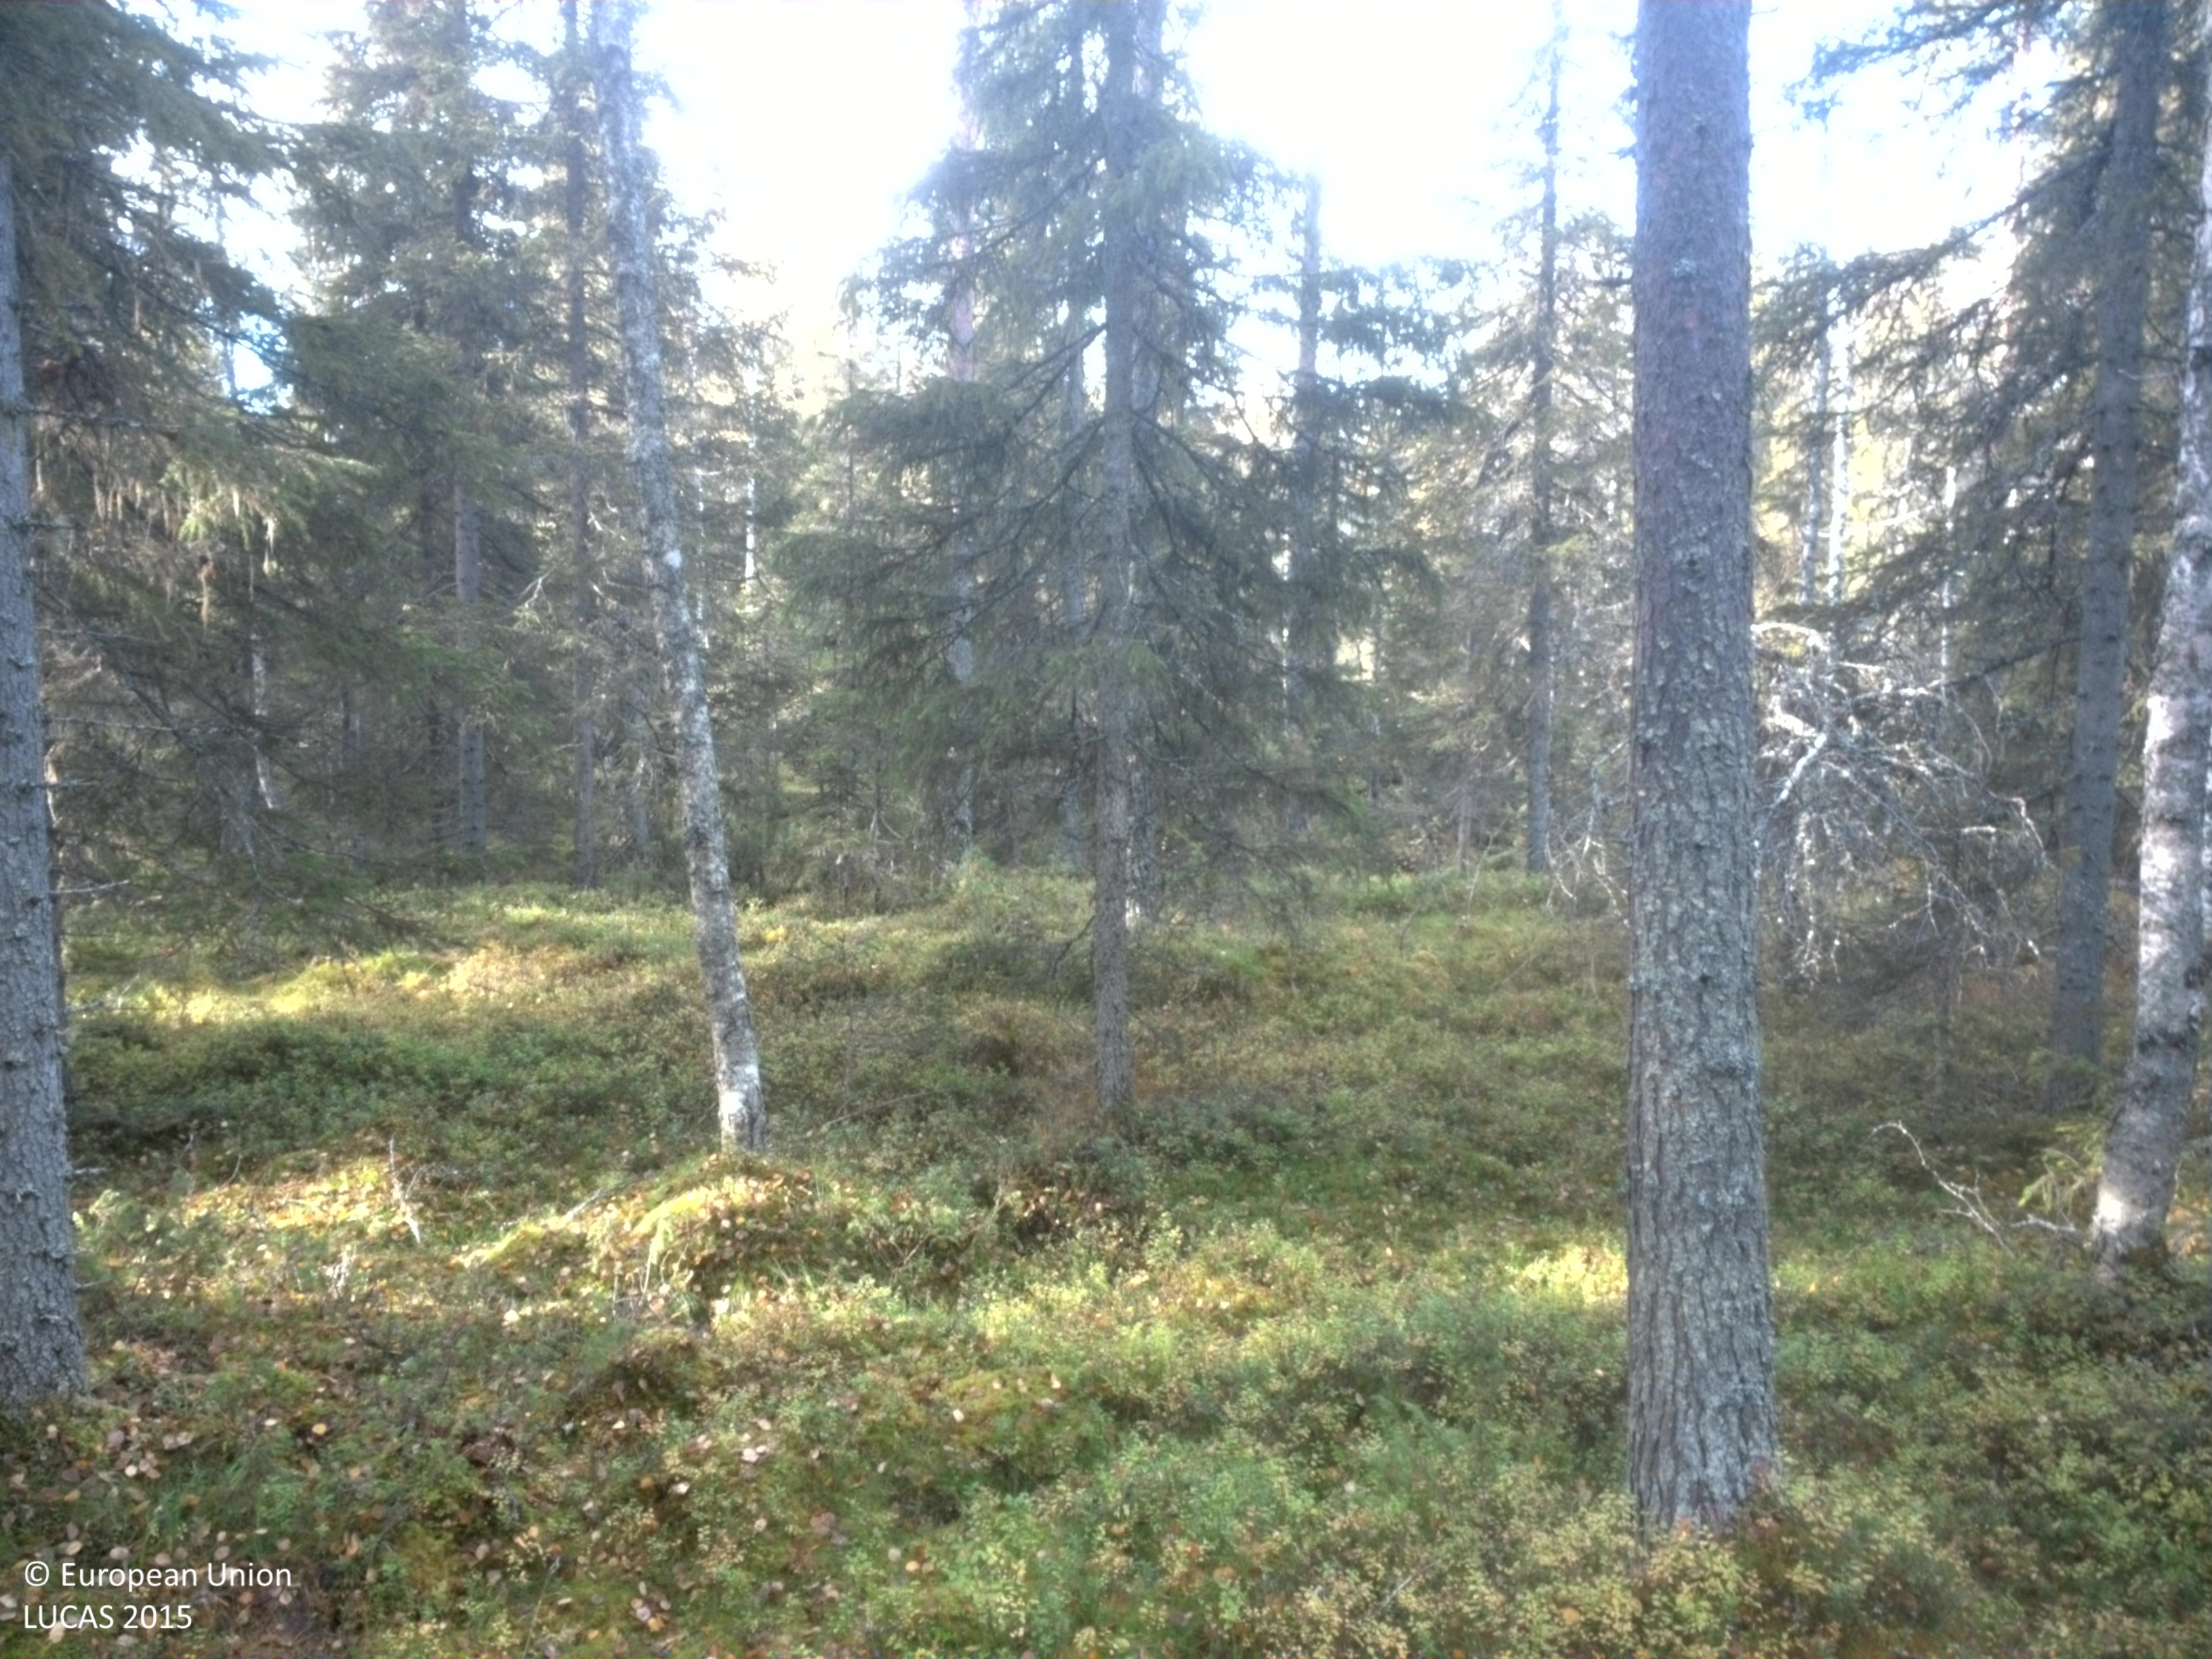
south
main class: Woodland
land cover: Spruce dominated coniferous woodland
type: boreal forest
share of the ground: 50 - 75 %
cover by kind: coniferous forest trees 55 %, shrubs 35 %, broadleaved forest trees 5 %, lichens and mosses 5 %
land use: Forestry
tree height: > 5 m
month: September
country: SE
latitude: 64.2523
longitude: 19.8998
